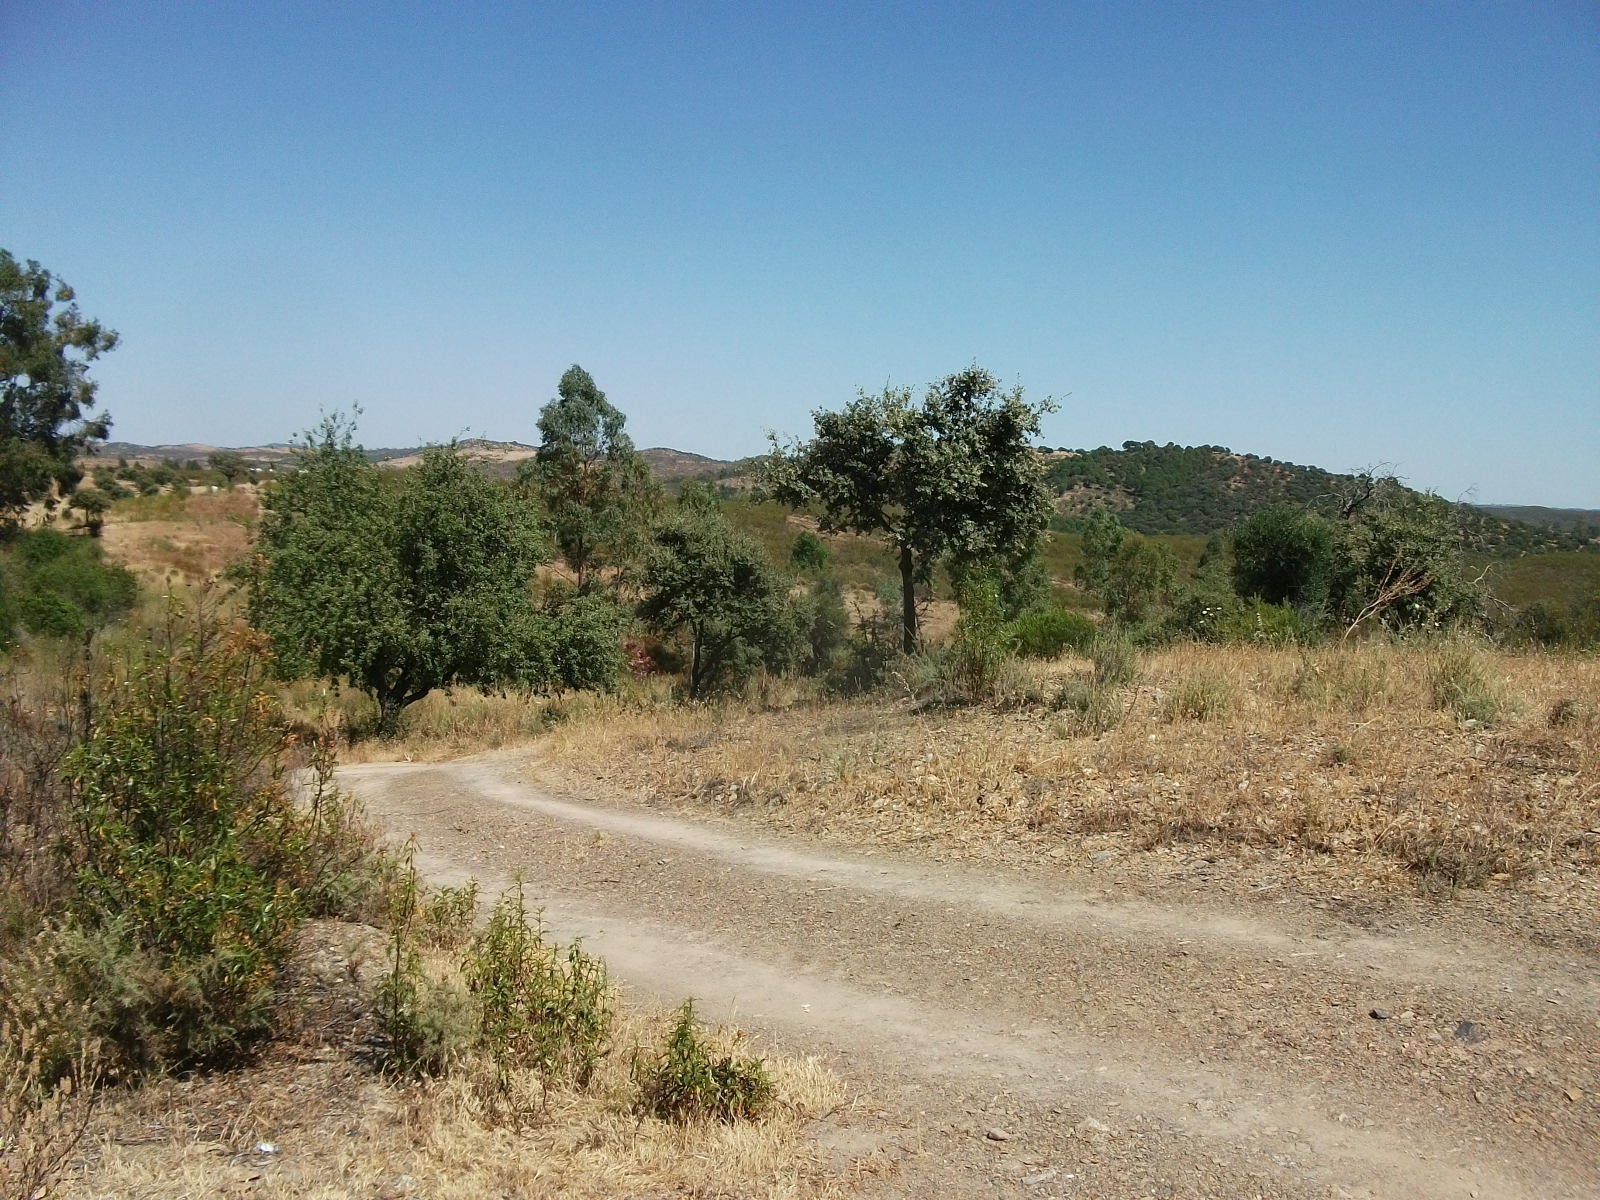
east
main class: Woodland
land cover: Broadleaved woodland
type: broadleaved evergreen forest
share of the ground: > 75 %
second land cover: Spontaneously vegetated surfaces
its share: < 10 %
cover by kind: broadleaved forest trees 80 %, shrubs 10 %, herbaceous plants 10 %
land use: Forestry
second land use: Agriculture (excluding fallow land and kitchen gardens)
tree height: > 5 m
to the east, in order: Broadleaved woodland; Spontaneously vegetated surfaces; Tracks; Fences; Grassland without tree/shrub cover; Fences; Broadleaved woodland; Fences; Broadleaved woodland
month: June
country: ES
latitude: 37.7179
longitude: -7.0088
